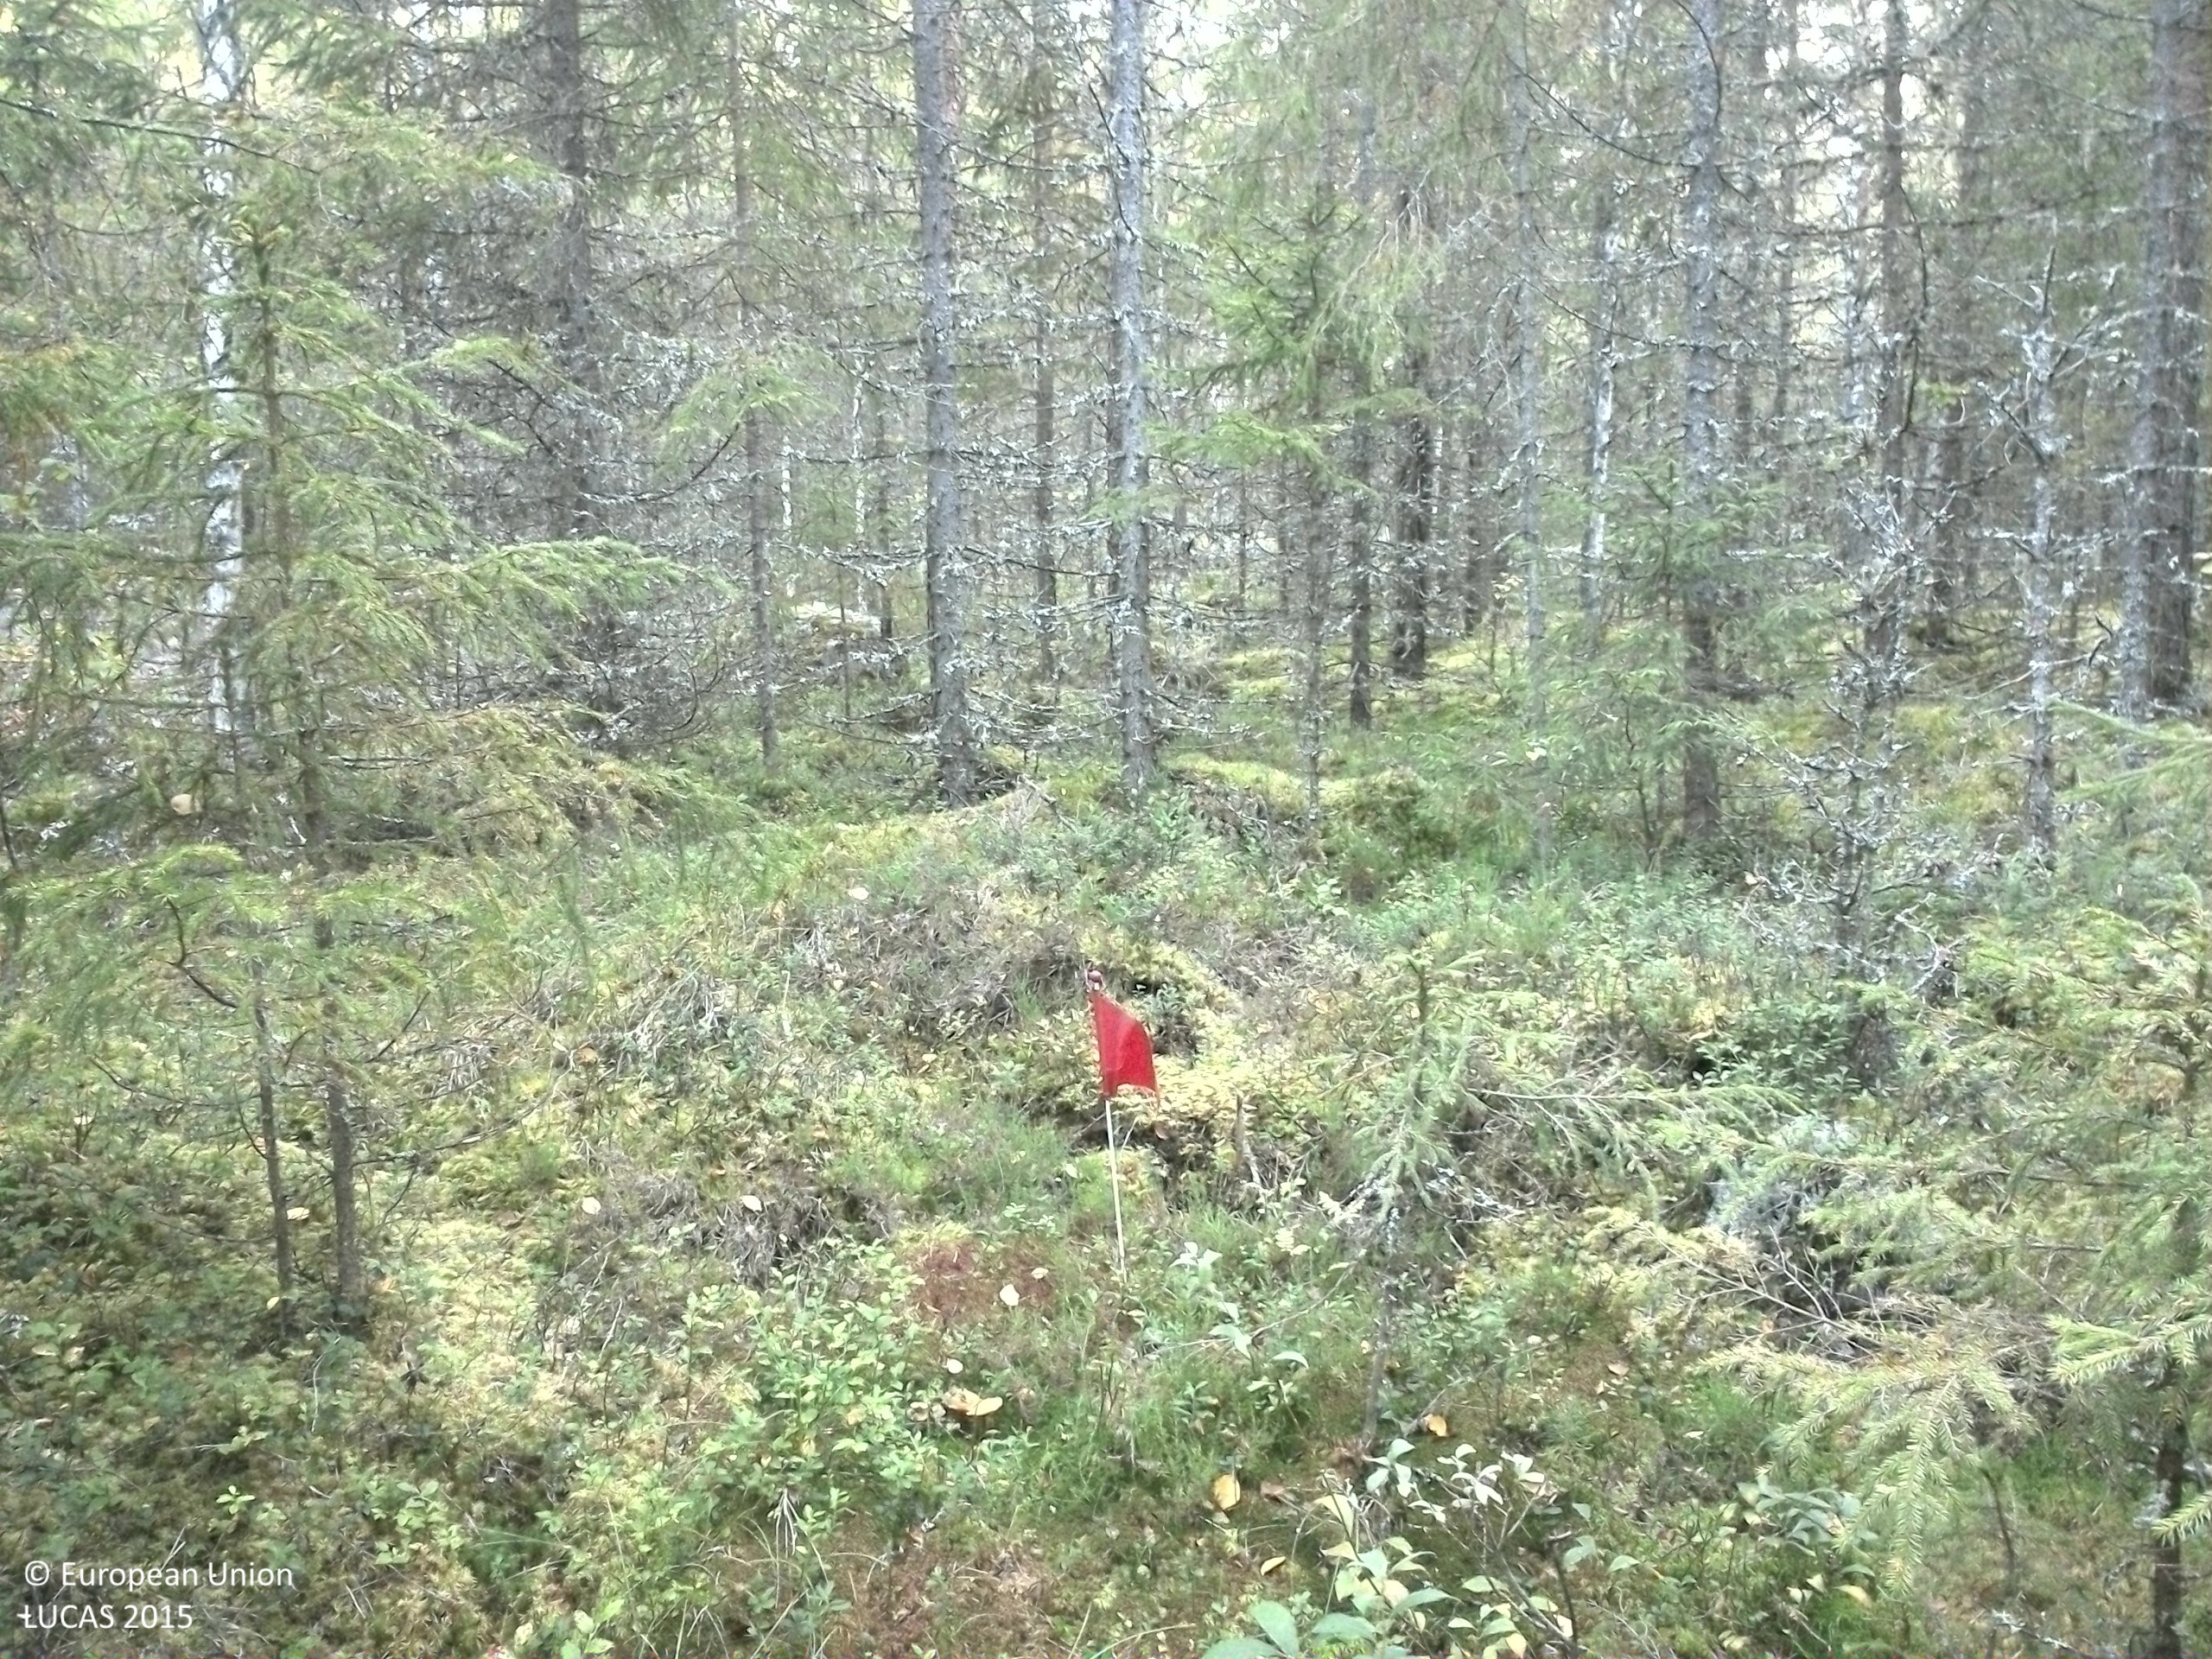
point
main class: Woodland
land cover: Spruce dominated coniferous woodland
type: boreal forest
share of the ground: 50 - 75 %
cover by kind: coniferous forest trees 70 %, shrubs 15 %, lichens and mosses 10 %, broadleaved forest trees 5 %
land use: Forestry
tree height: > 5 m
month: September
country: SE
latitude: 59.9036
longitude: 13.4773
